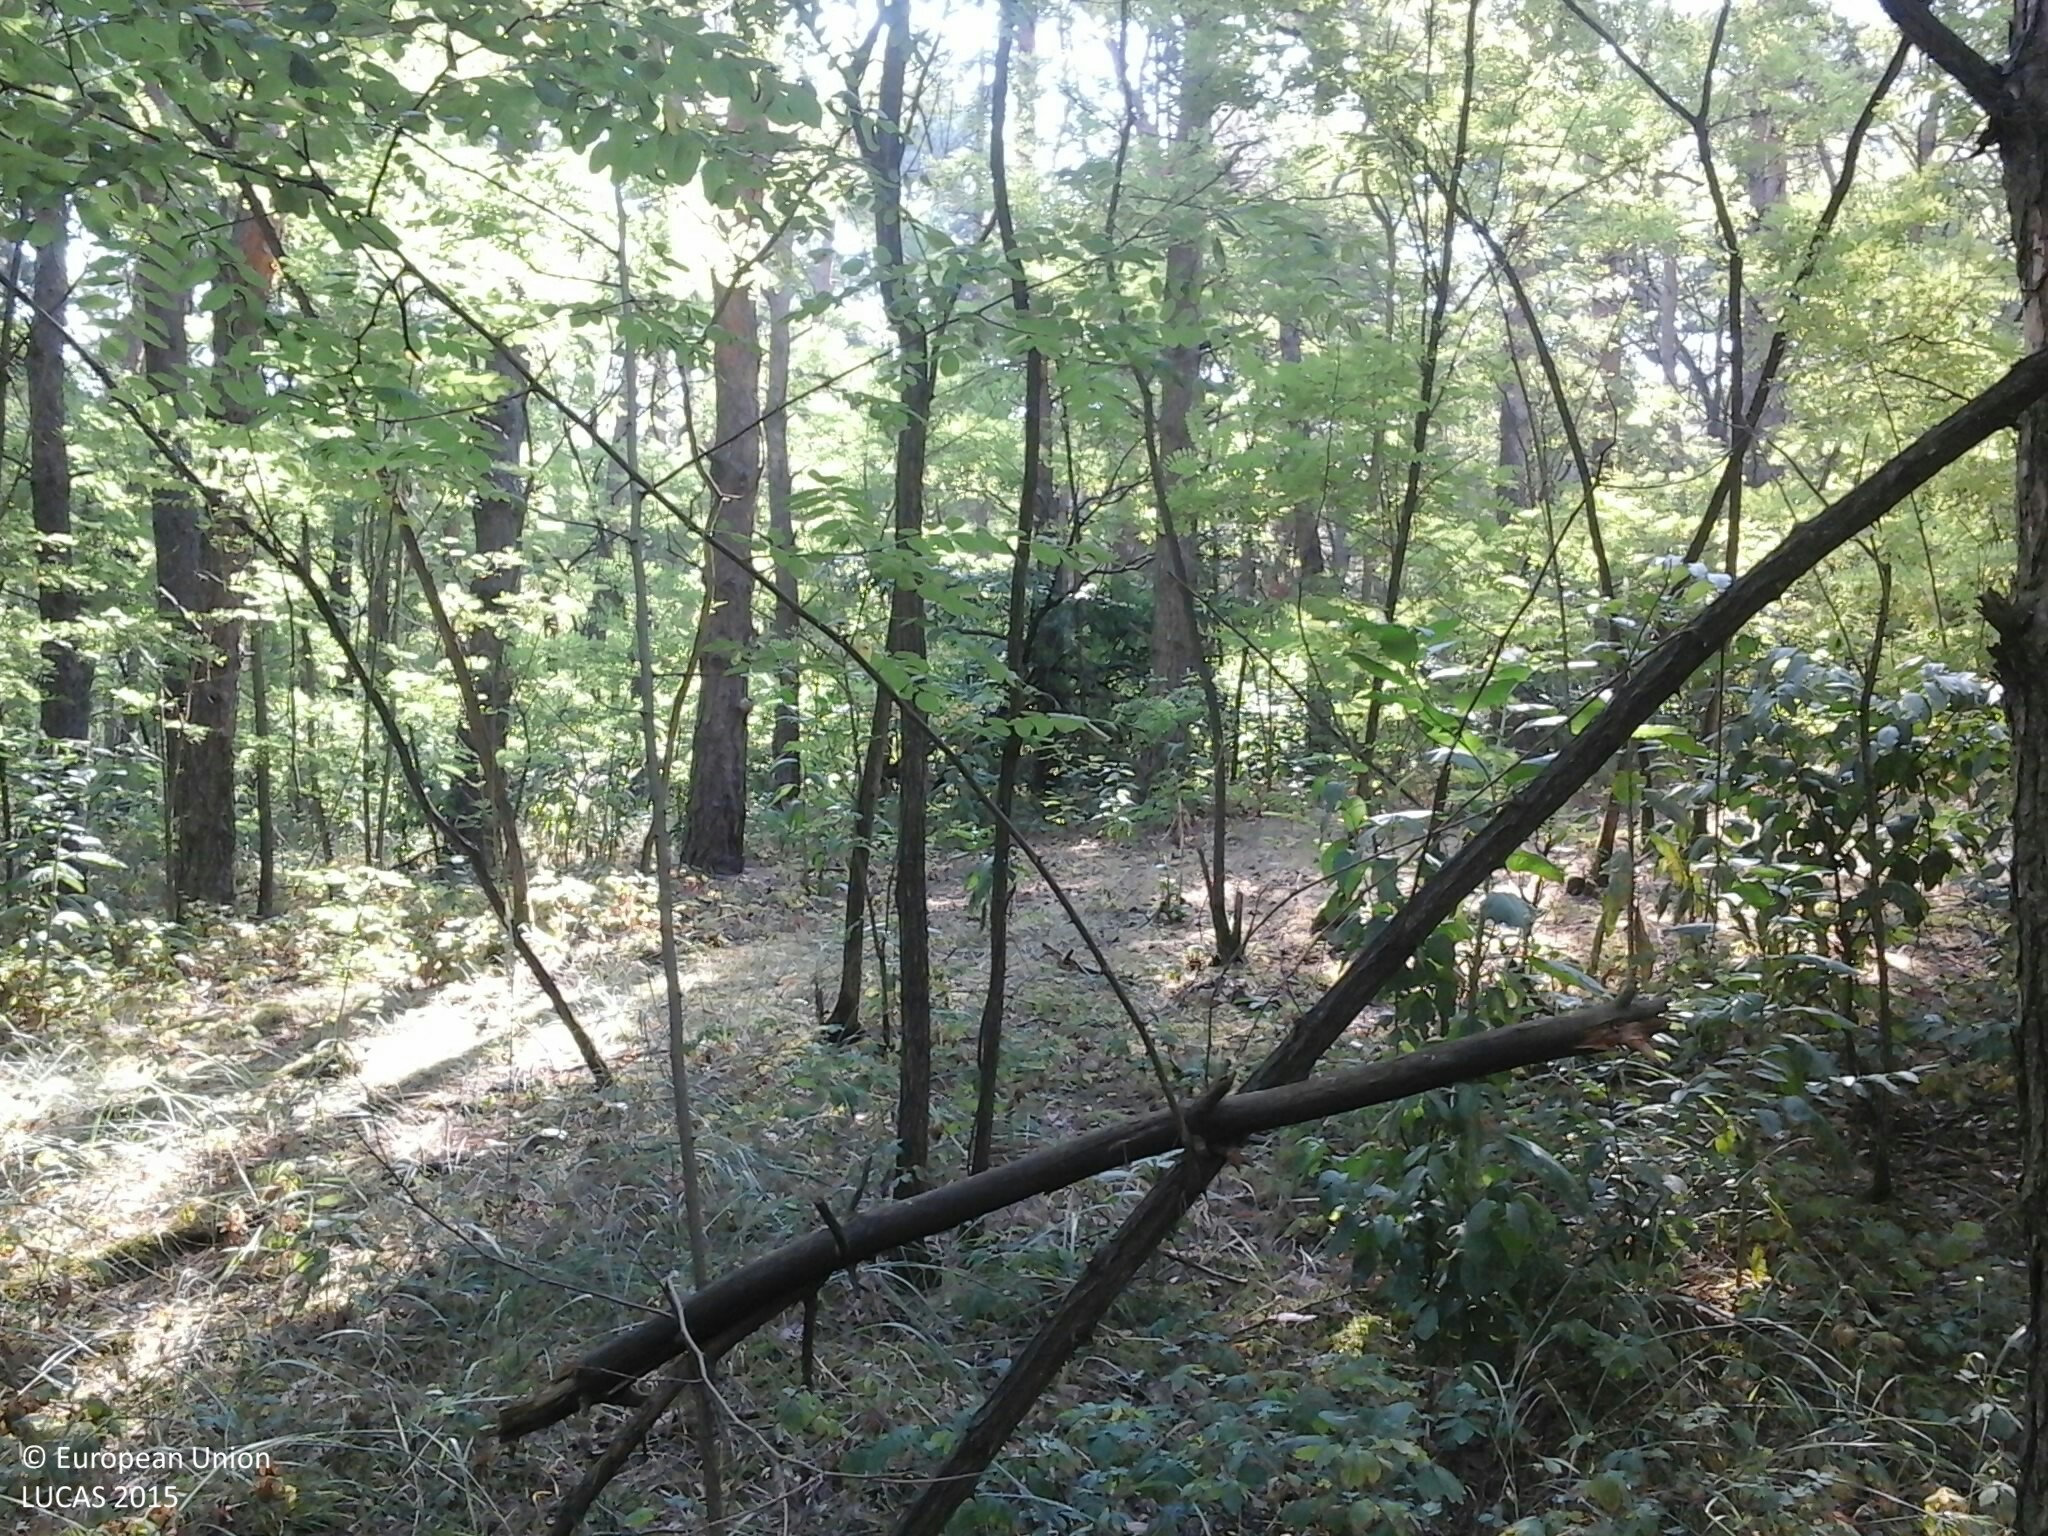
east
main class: Woodland
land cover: Pine dominated coniferous woodland
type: non-riverine alder, birch or aspen forest
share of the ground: 50 - 75 %
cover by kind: coniferous forest trees 75 %, broadleaved forest trees 20 %, herbaceous plants 5 %
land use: Forestry
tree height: > 5 m
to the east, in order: Pine dominated coniferous woodland; Tracks; Broadleaved woodland
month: July
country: HU
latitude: 47.9139
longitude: 21.9732
